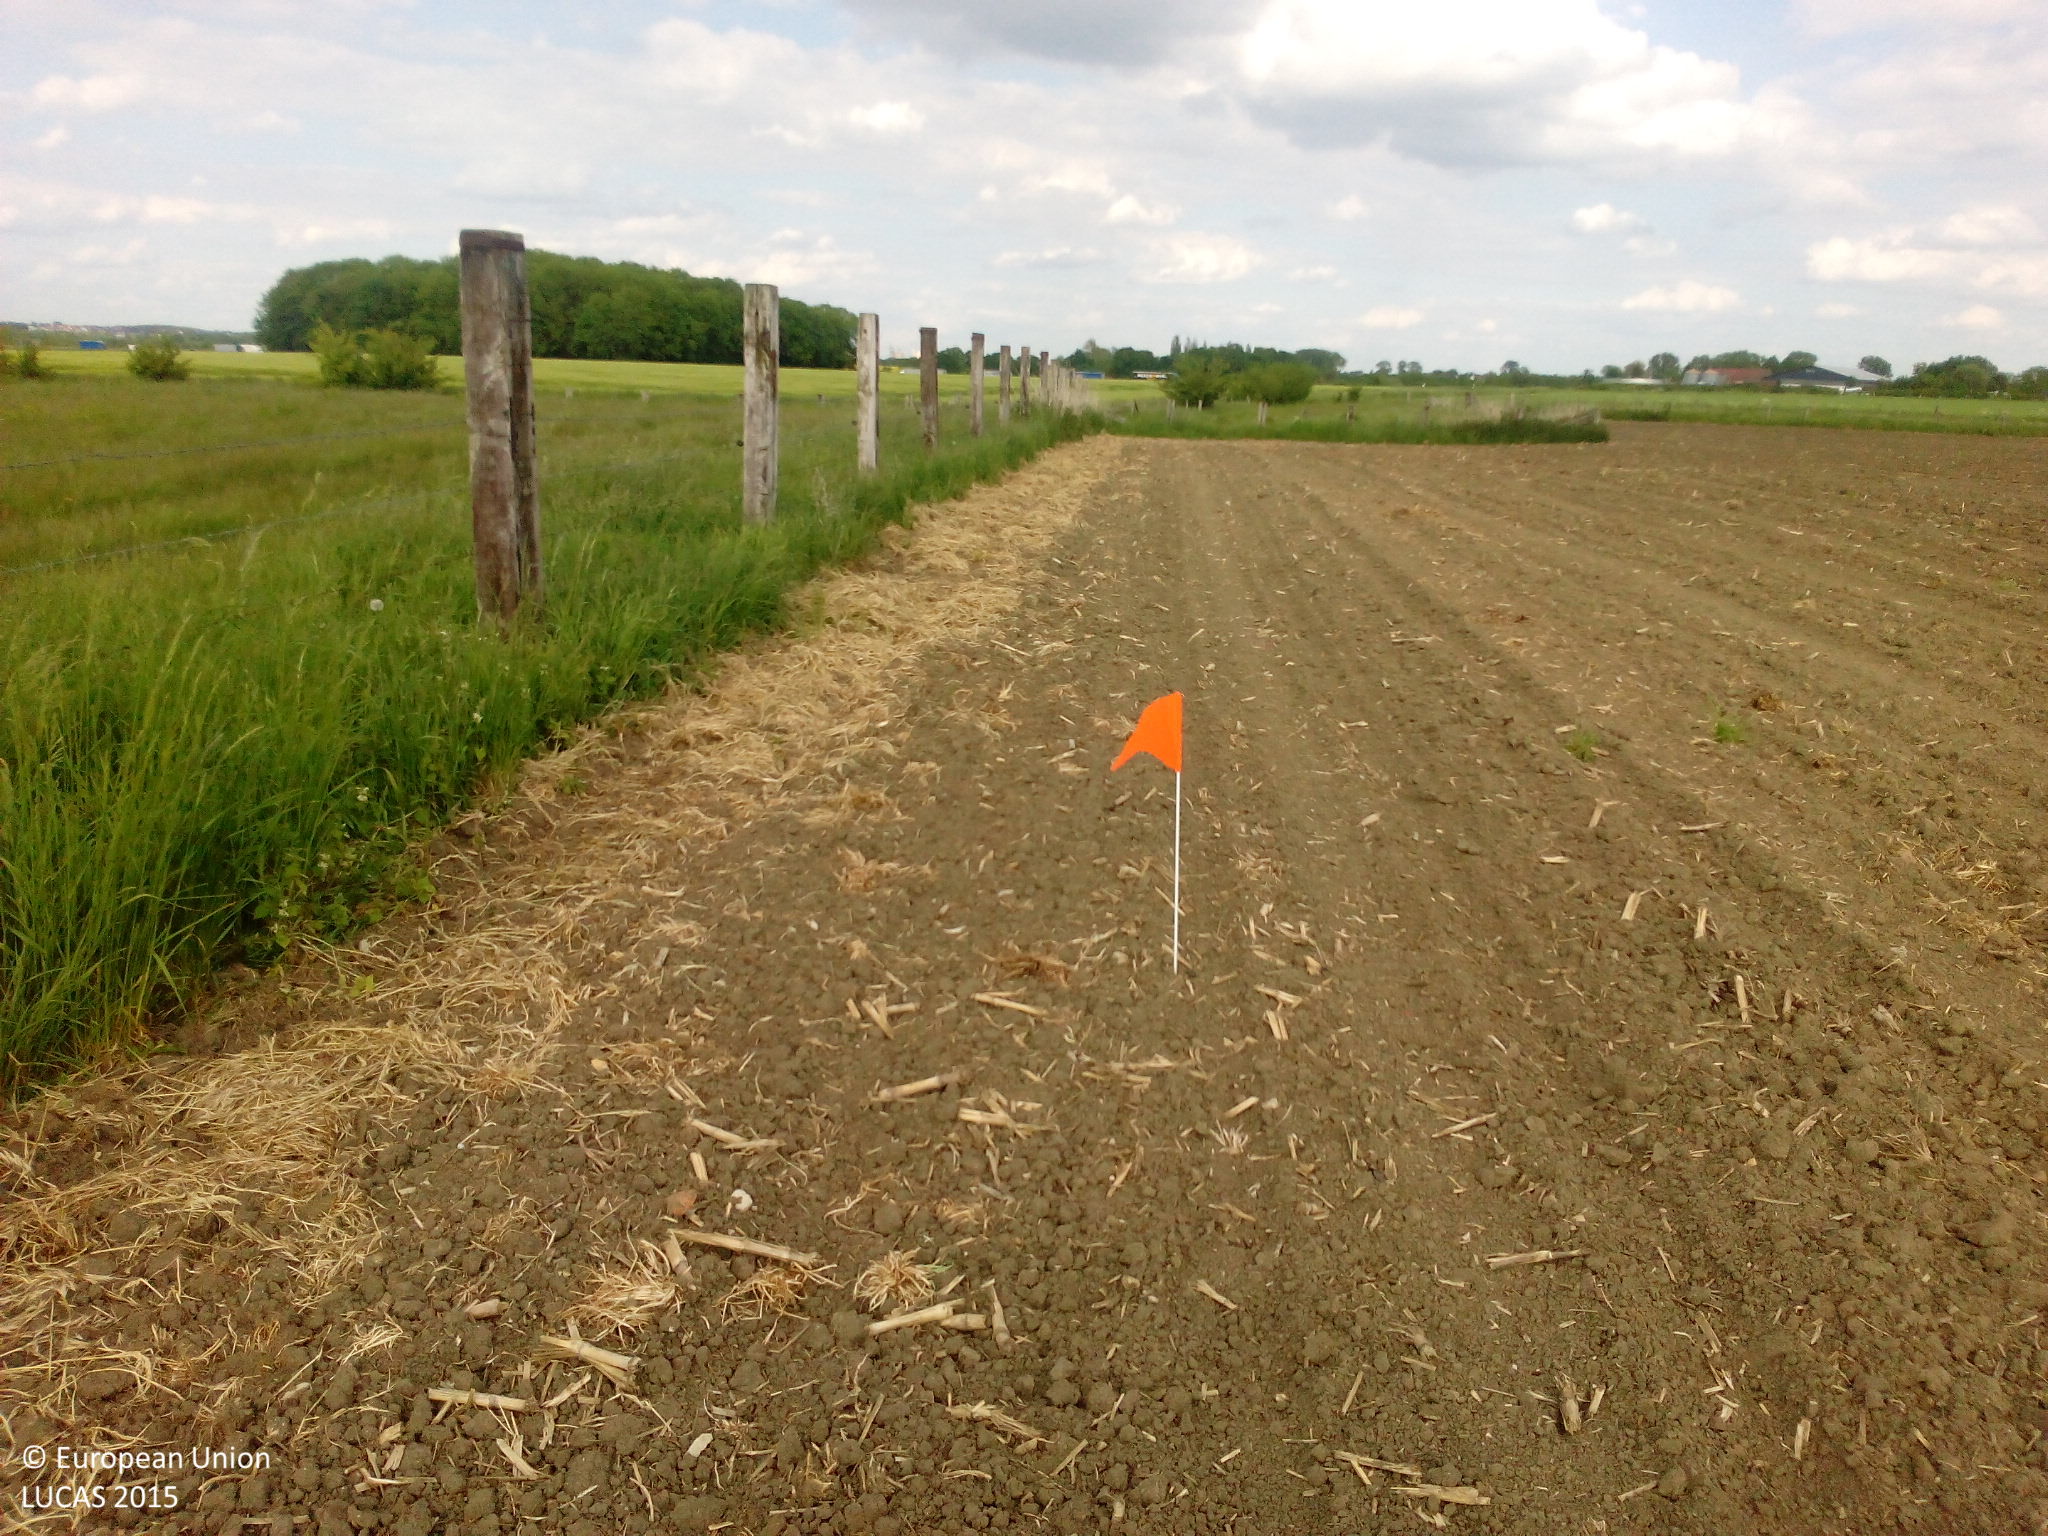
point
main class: Cropland
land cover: Maize
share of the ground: < 10 %
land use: Agriculture (excluding fallow land and kitchen gardens)
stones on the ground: < 10 %
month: May
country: DE
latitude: 51.7491
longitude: 7.9870
